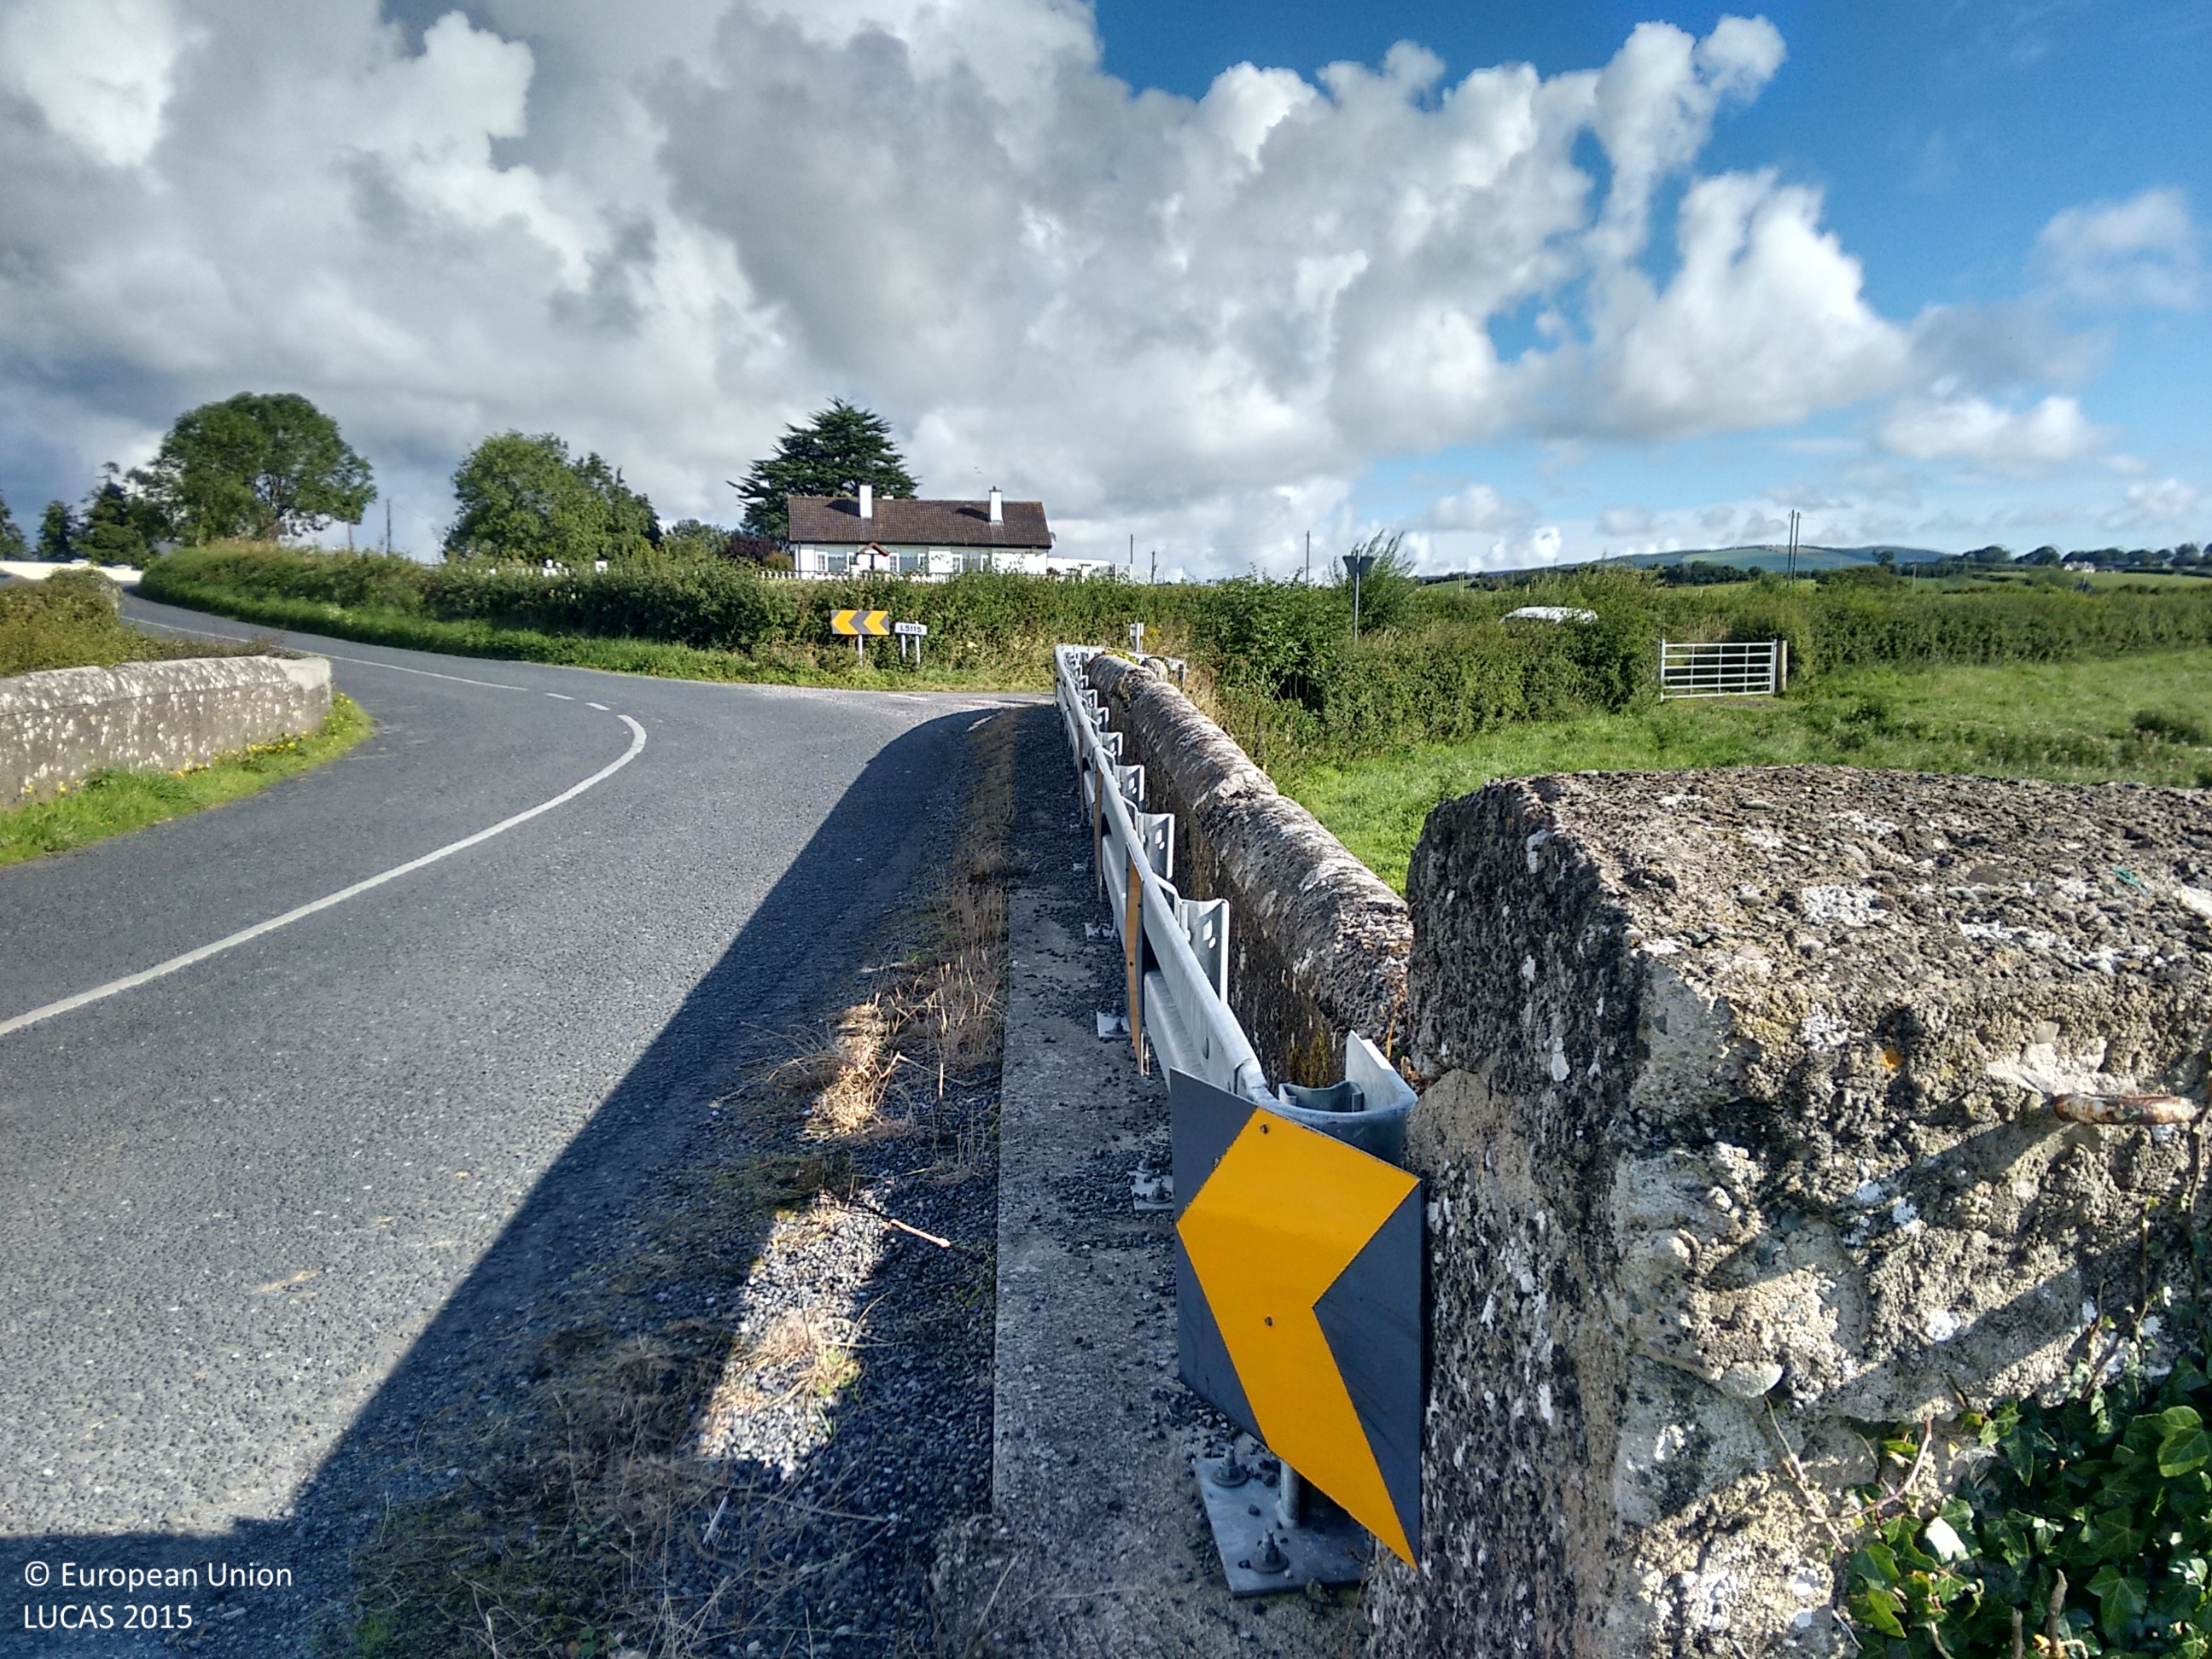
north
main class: Grassland
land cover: Grassland without tree/shrub cover
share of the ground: > 75 %
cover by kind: herbaceous plants 100 %
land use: Agriculture (excluding fallow land and kitchen gardens)
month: August
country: IE
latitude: 52.5682
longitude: -8.2584
